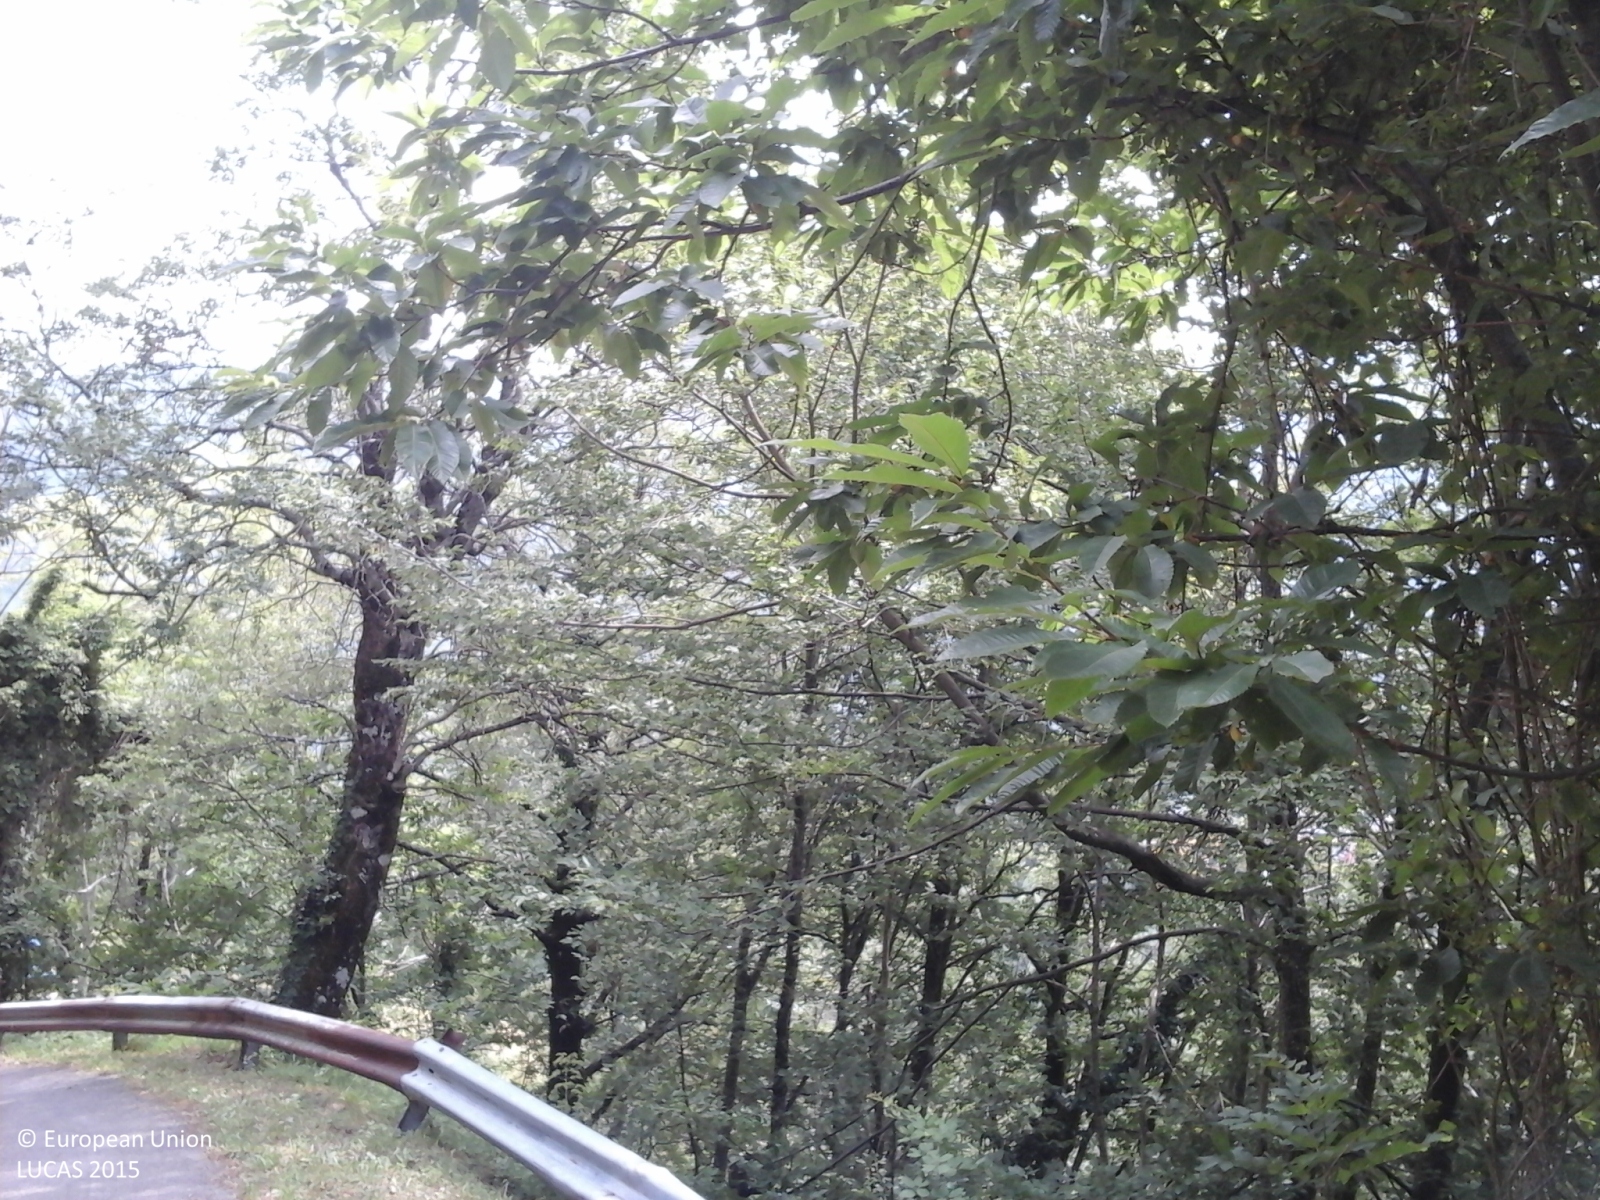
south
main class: Woodland
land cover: Broadleaved woodland
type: thermophilous deciduous forest
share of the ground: > 75 %
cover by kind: broadleaved forest trees 90 %, herbaceous plants 10 %
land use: Forestry
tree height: > 5 m
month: July
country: IT
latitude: 44.2035
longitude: 10.7615
